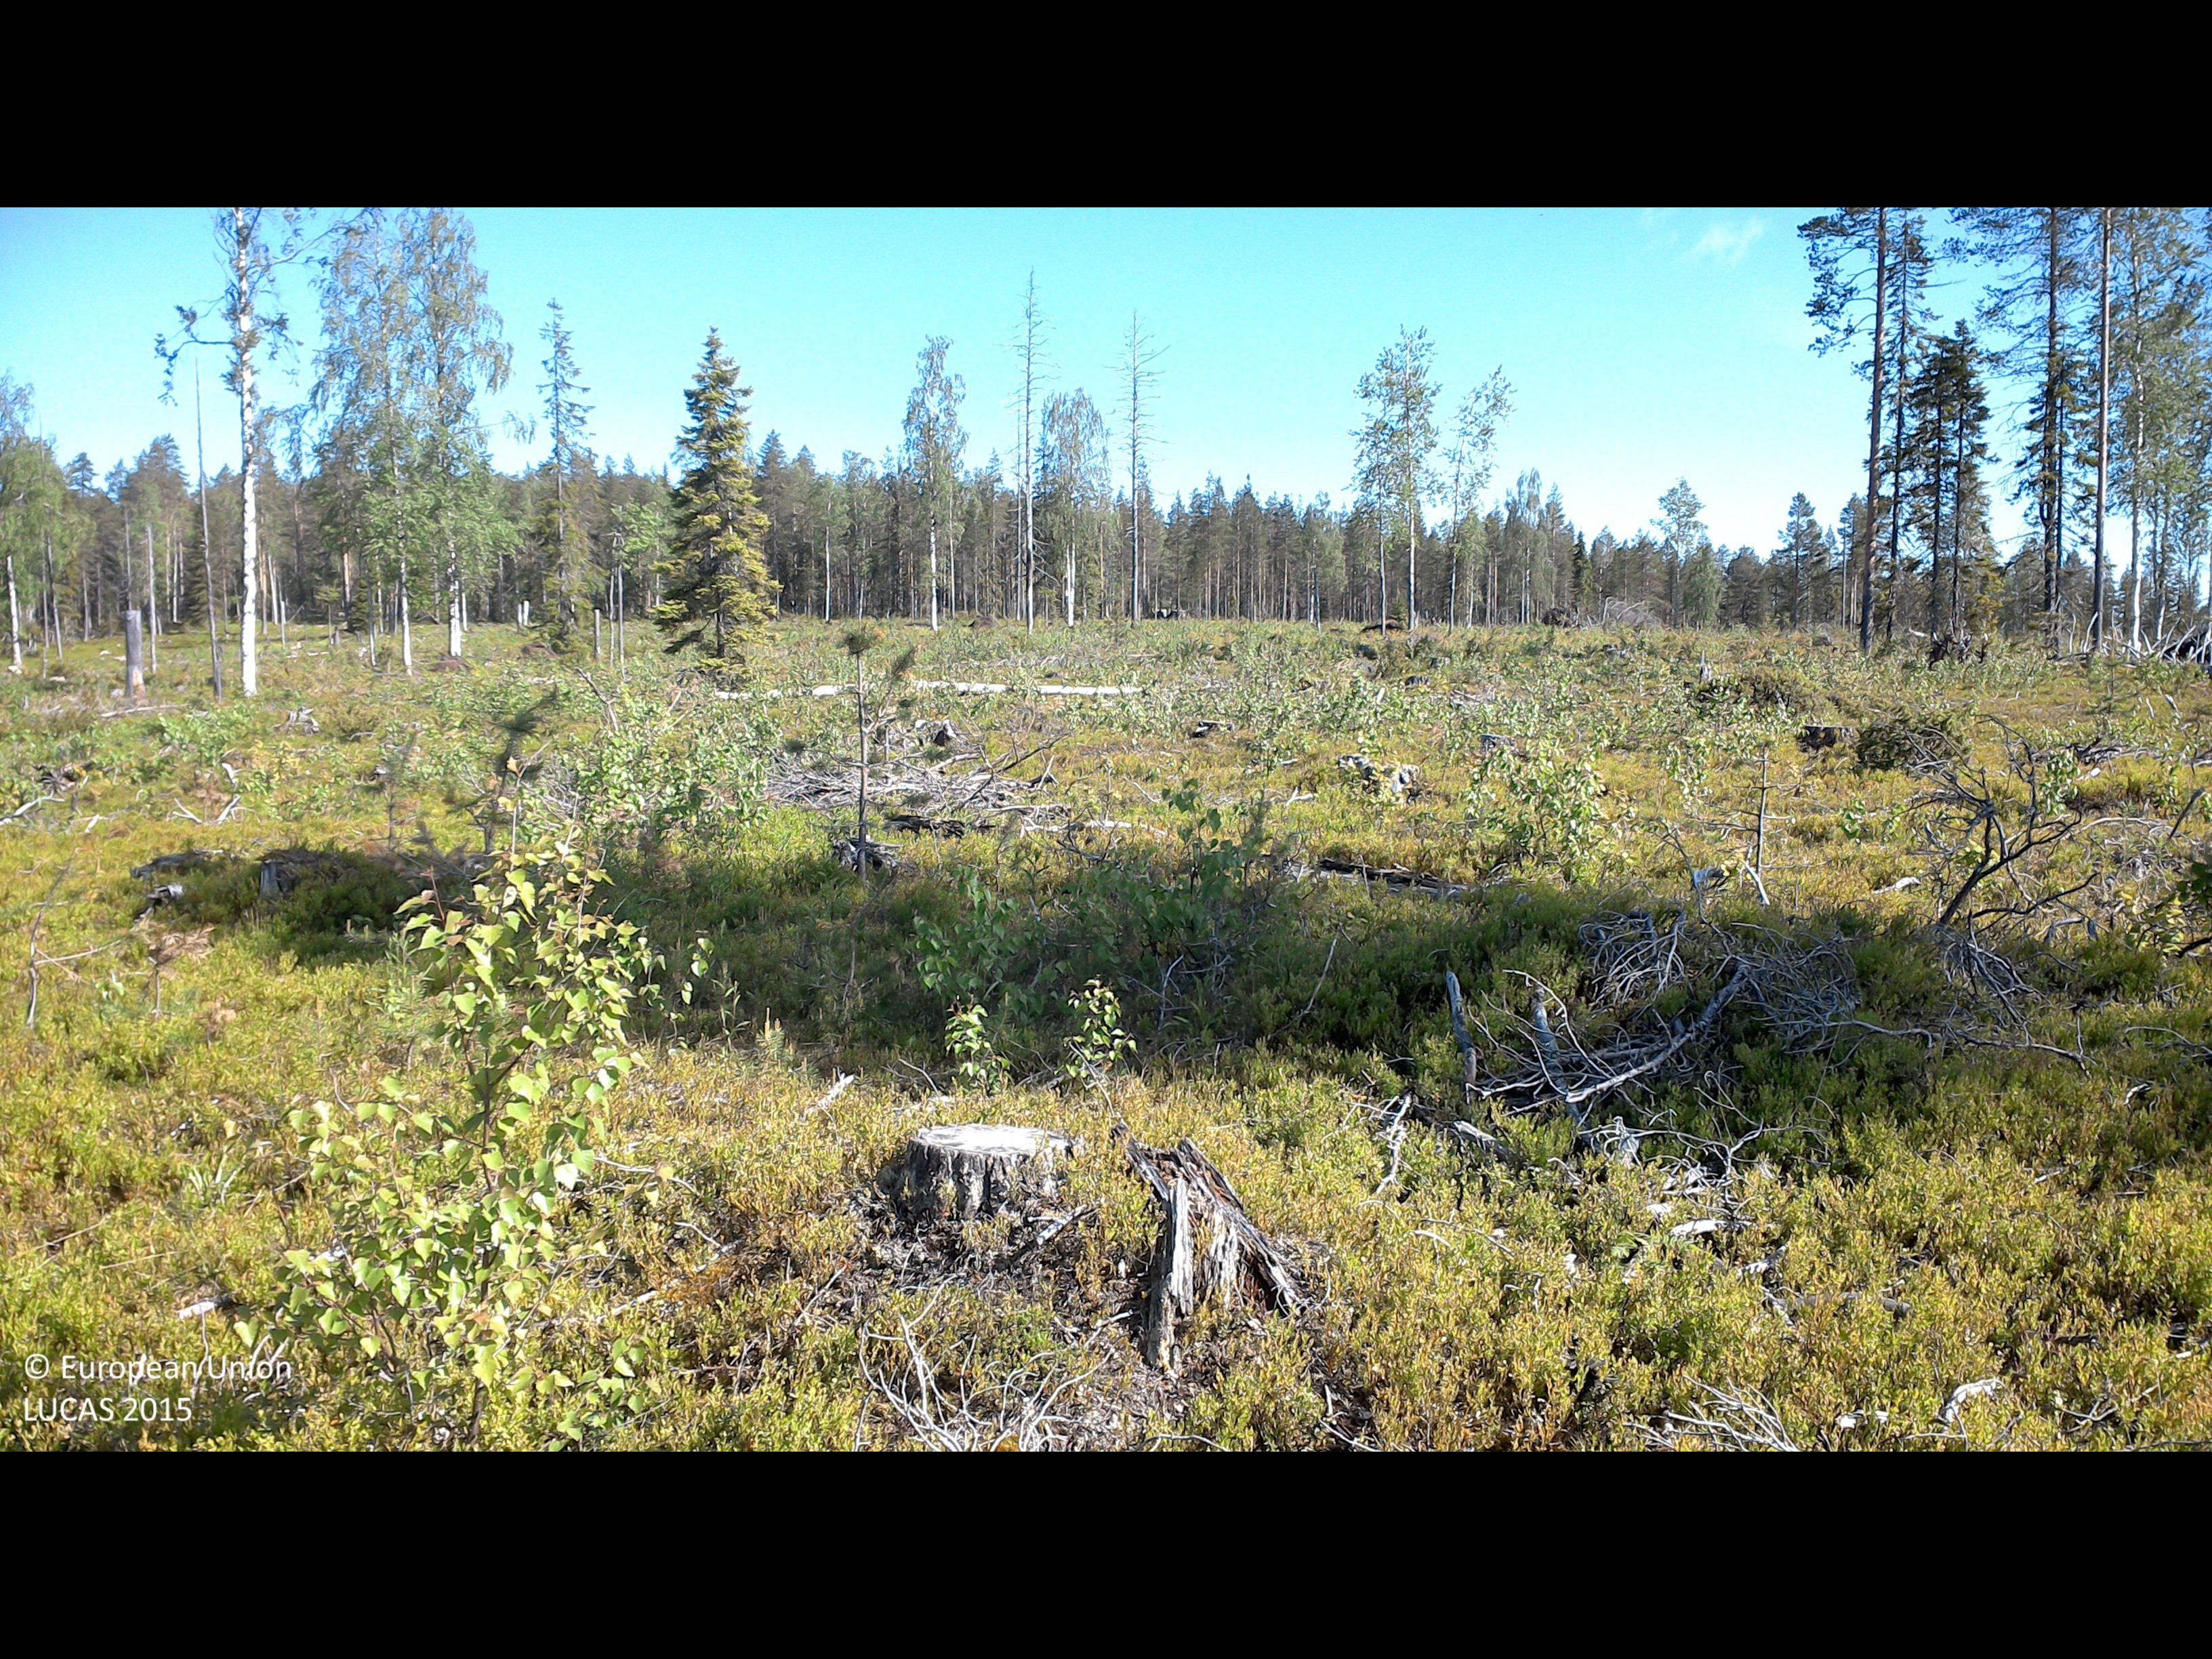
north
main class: Woodland
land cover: Broadleaved woodland
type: boreal forest
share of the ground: 10 - 25 %
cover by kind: shrubs 85 %, broadleaved forest trees 10 %, lichens and mosses 5 %
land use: Forestry
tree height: < 5 m
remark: Clear cut
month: June
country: SE
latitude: 66.6860
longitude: 22.5822
